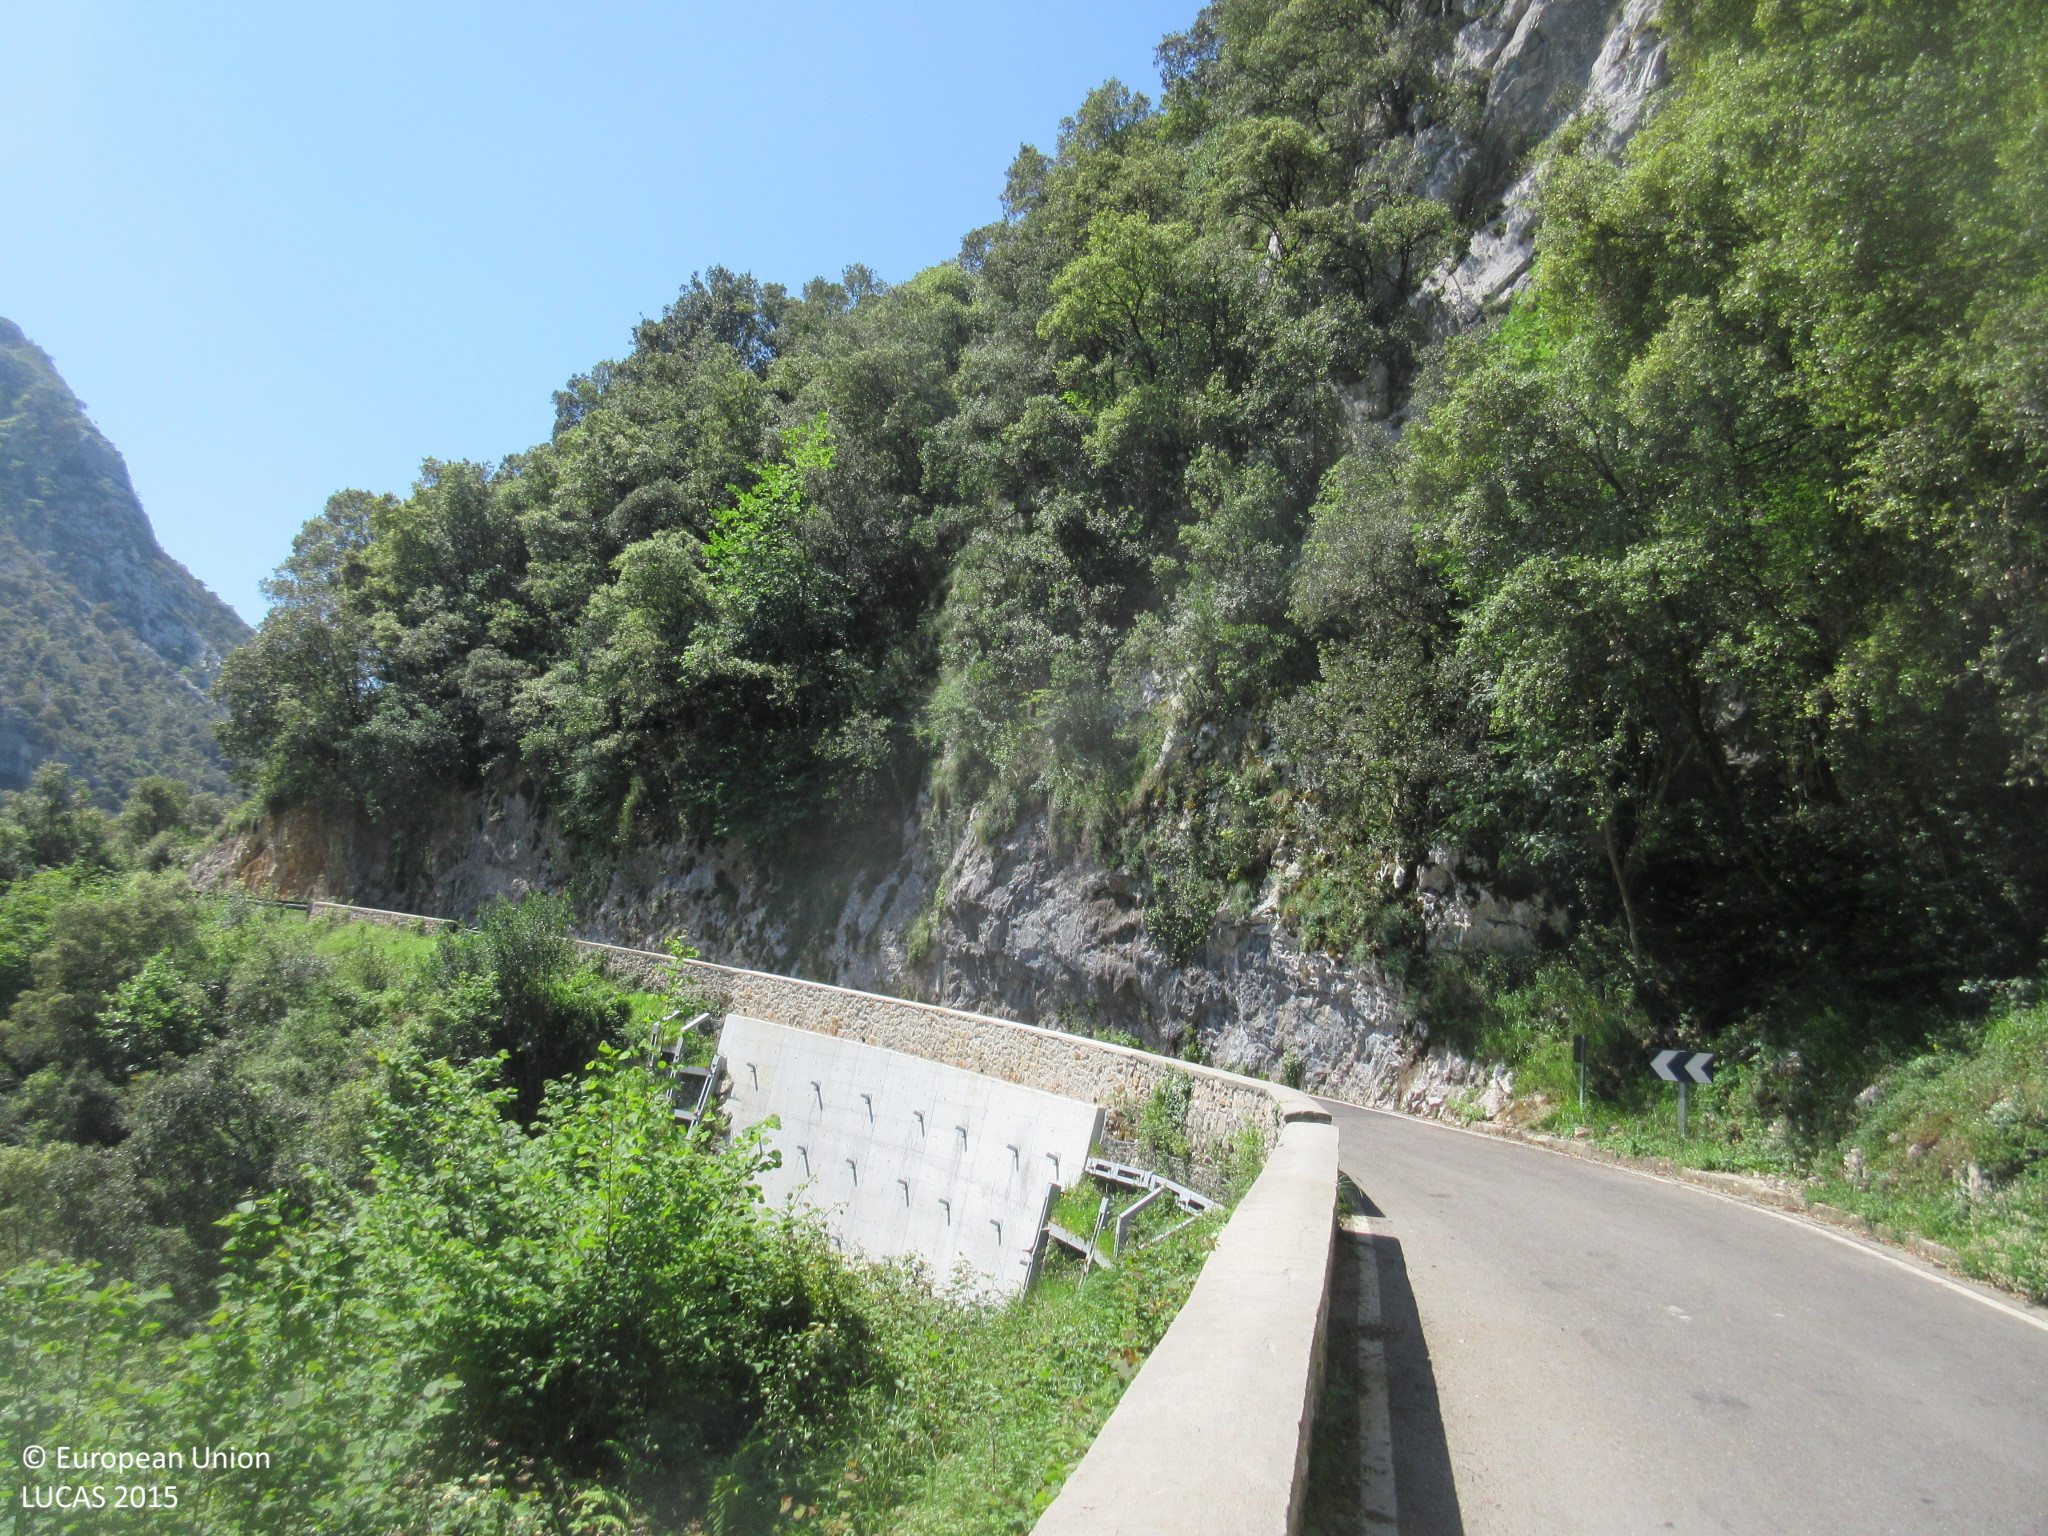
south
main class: Woodland
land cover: Broadleaved woodland
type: broadleaved evergreen forest
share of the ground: > 75 %
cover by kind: broadleaved forest trees 90 %, shrubs 5 %, herbaceous plants 5 %
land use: Semi-natural and natural areas not in use
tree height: > 5 m
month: May
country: ES
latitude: 43.2726
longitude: -4.4874
